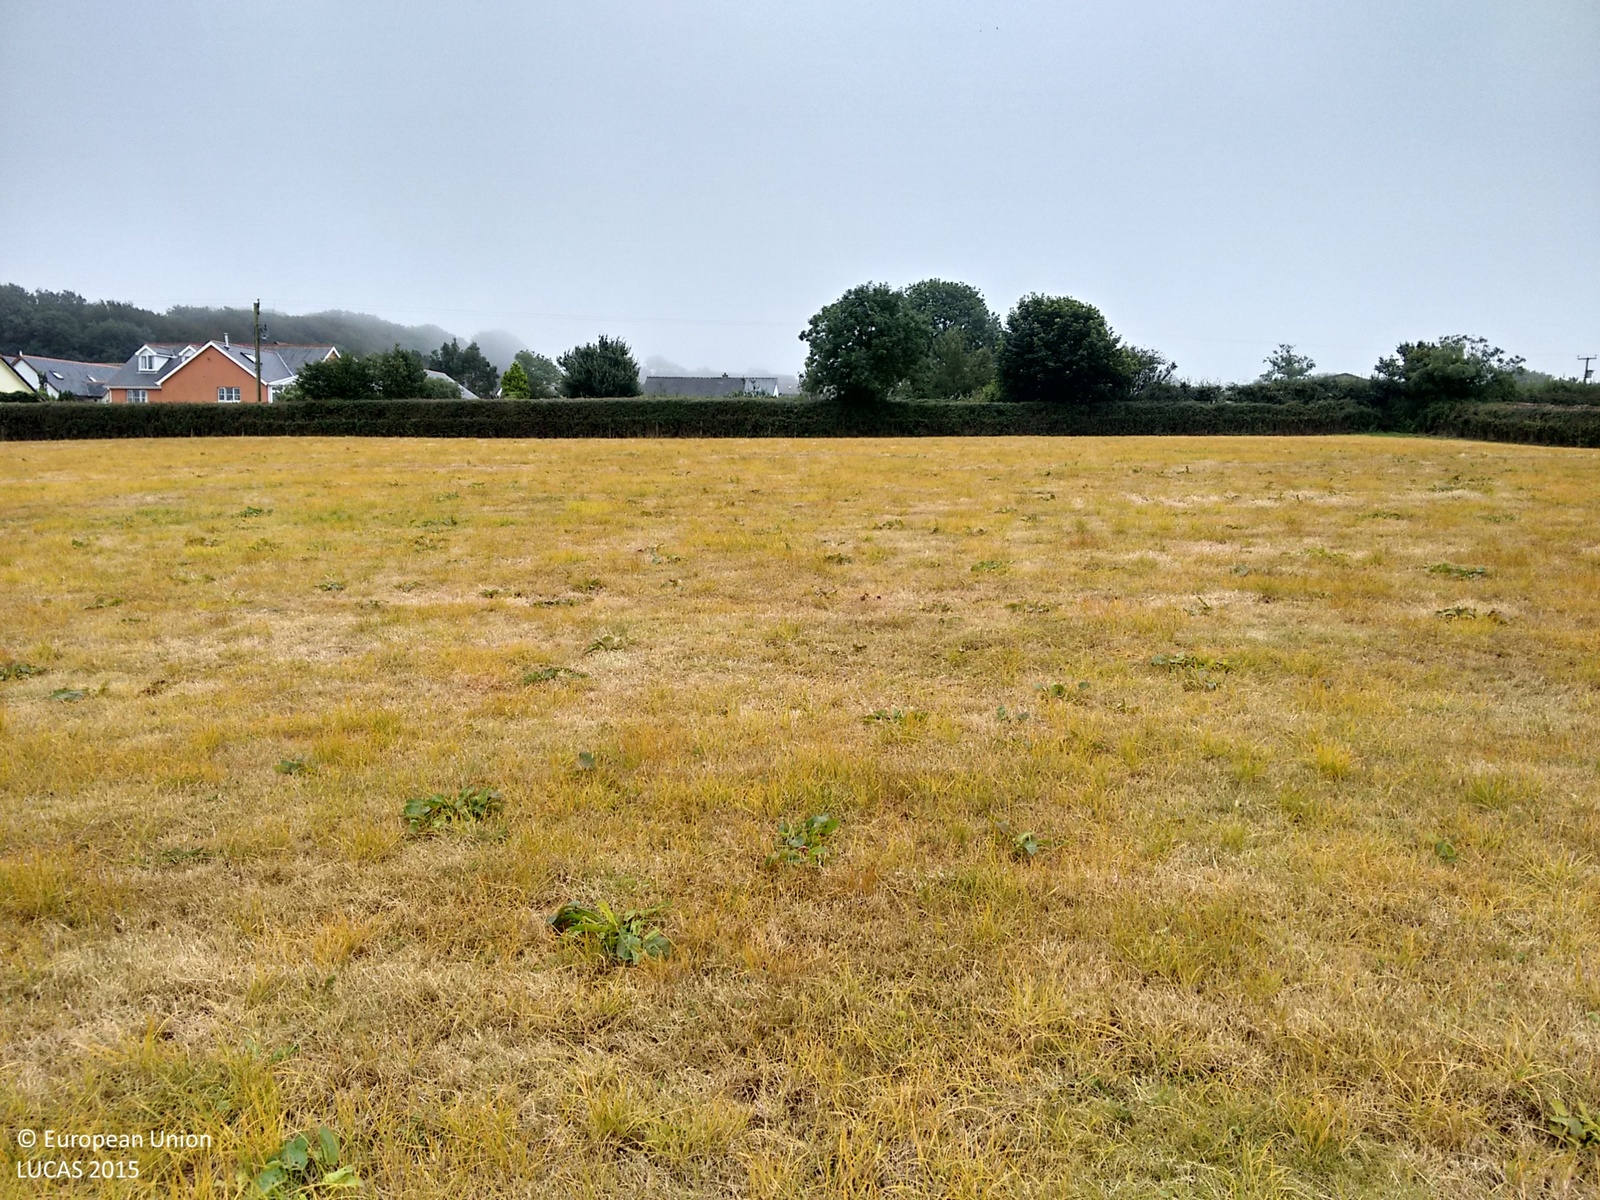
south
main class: Grassland
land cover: Grassland without tree/shrub cover
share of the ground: > 75 %
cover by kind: herbaceous plants 100 %
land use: Agriculture (excluding fallow land and kitchen gardens)
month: August
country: GB
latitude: 51.7836
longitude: -4.7076
